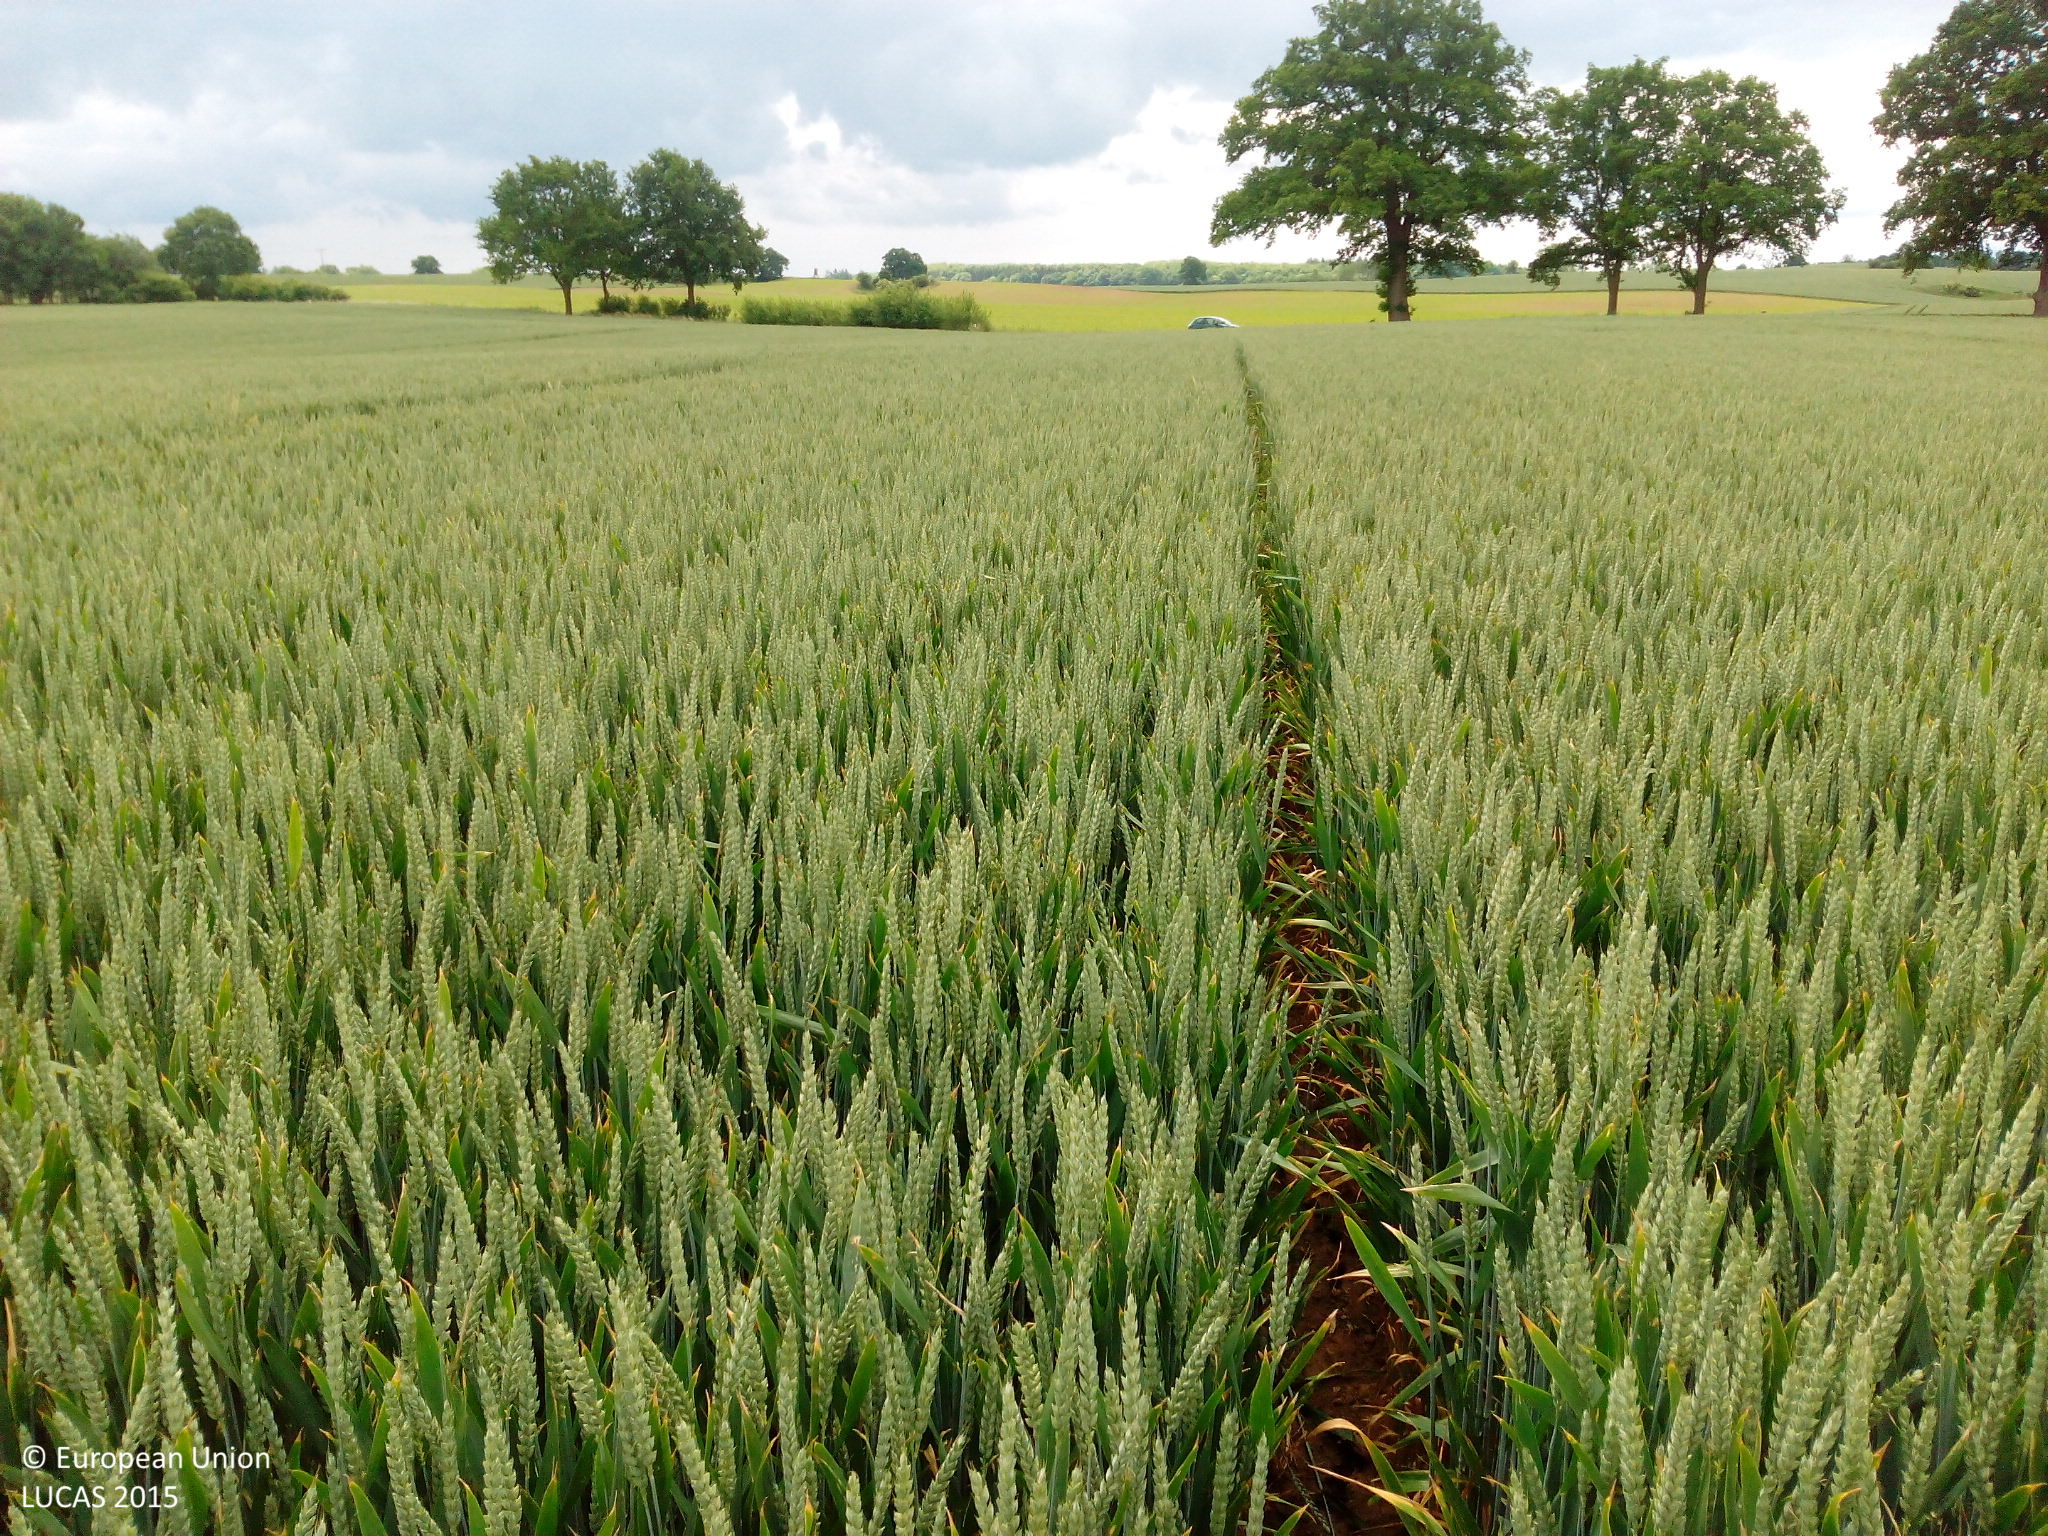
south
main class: Cropland
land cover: Common wheat
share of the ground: > 75 %
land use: Agriculture (excluding fallow land and kitchen gardens)
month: June
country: DE
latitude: 53.8100
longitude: 11.1384
